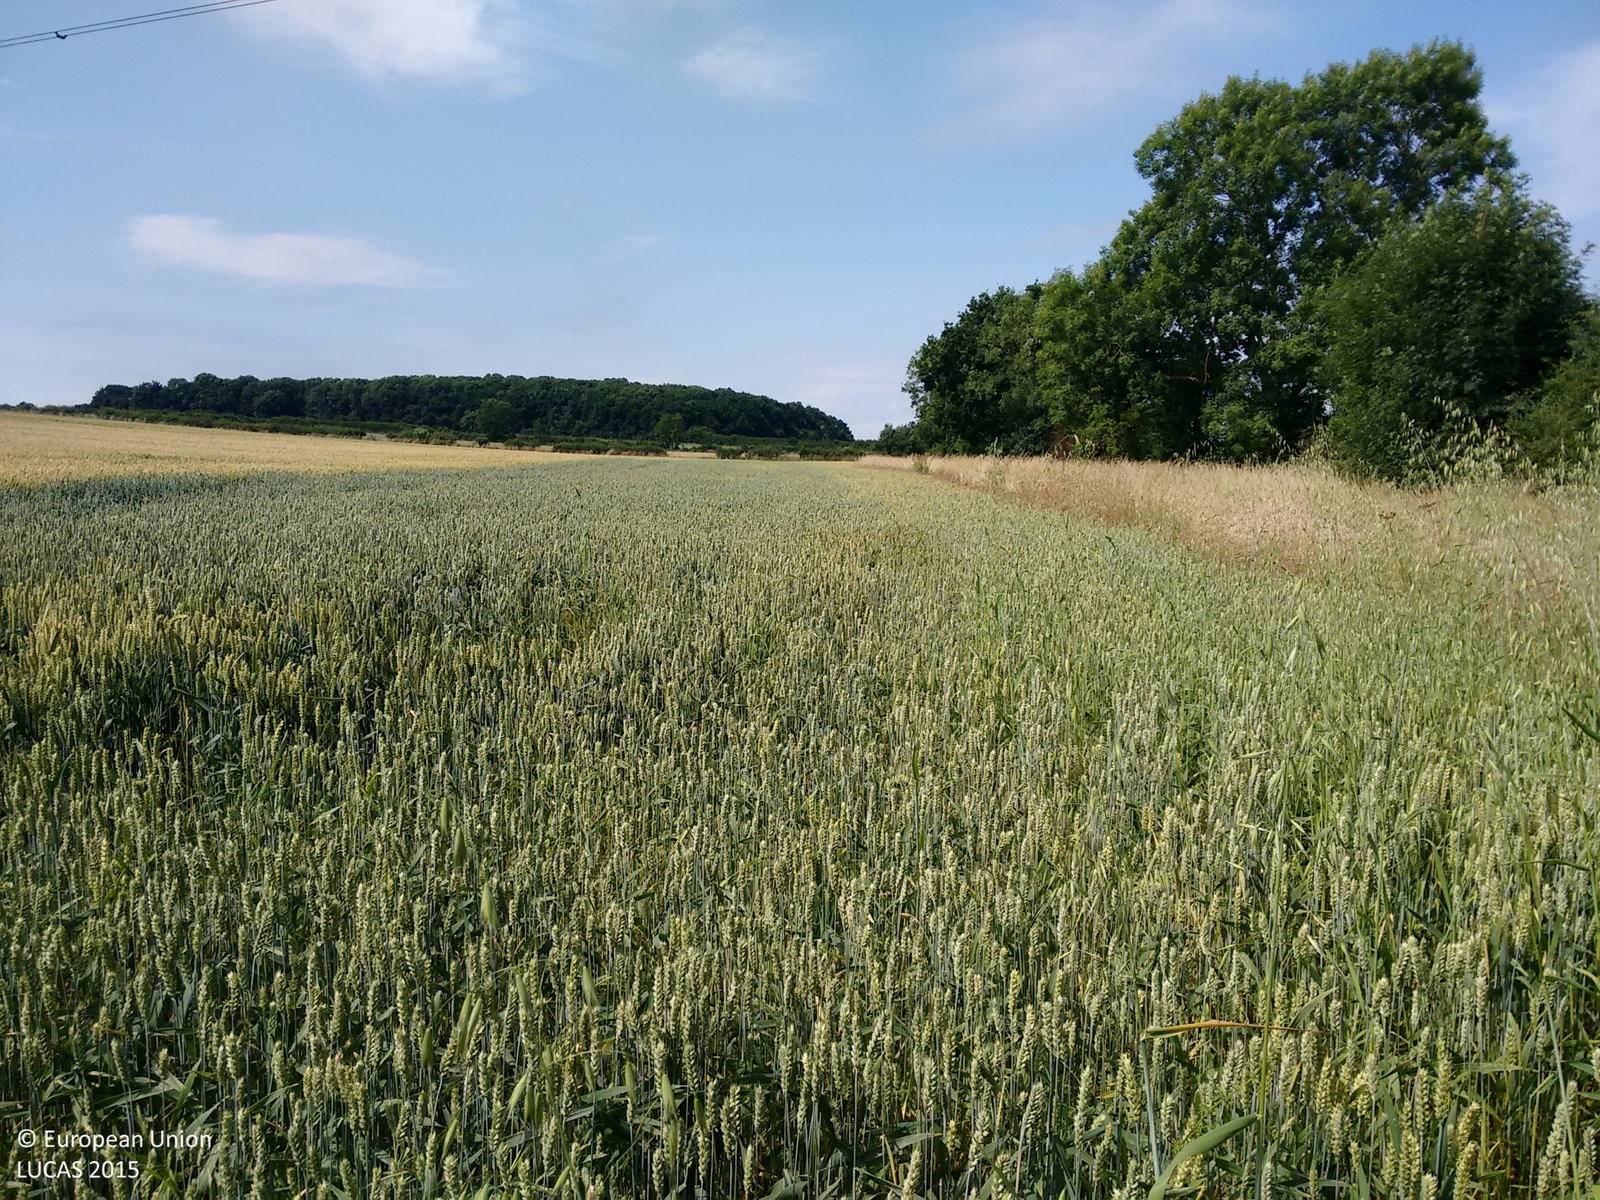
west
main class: Cropland
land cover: Common wheat
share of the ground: > 75 %
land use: Agriculture (excluding fallow land and kitchen gardens)
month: July
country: GB
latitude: 53.1690
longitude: -0.8270
